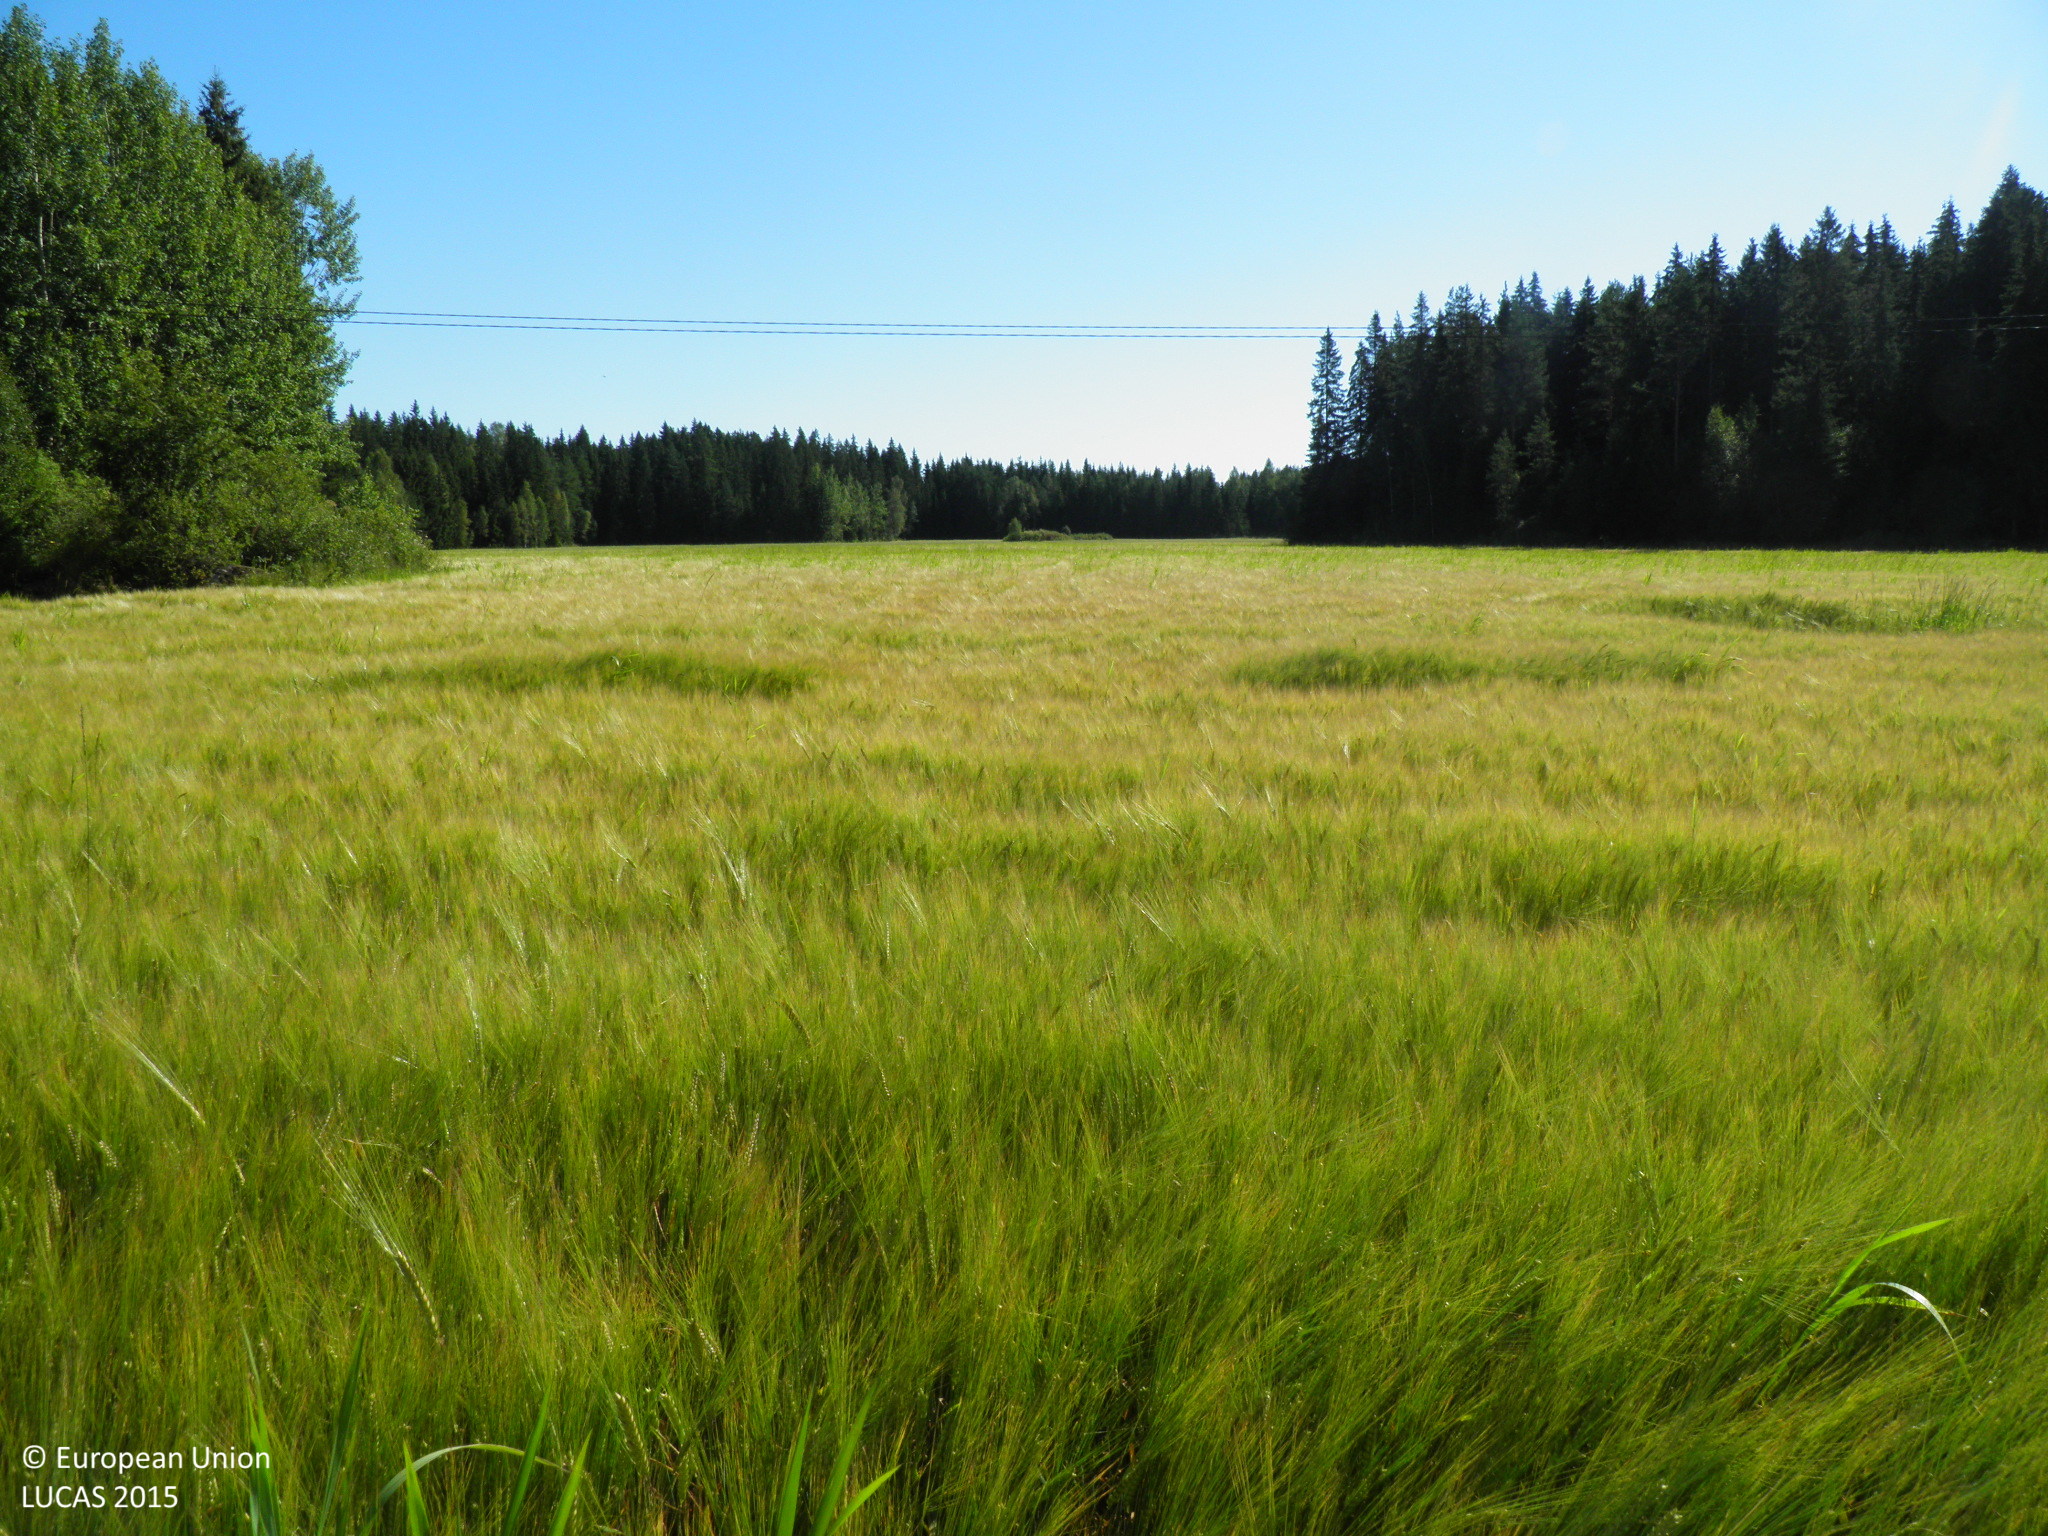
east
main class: Cropland
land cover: Barley
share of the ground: > 75 %
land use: Agriculture (excluding fallow land and kitchen gardens)
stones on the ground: < 10 %
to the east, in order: Barley; Electric lines; Barley; Oats
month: August
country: FI
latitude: 60.7631
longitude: 21.9731
